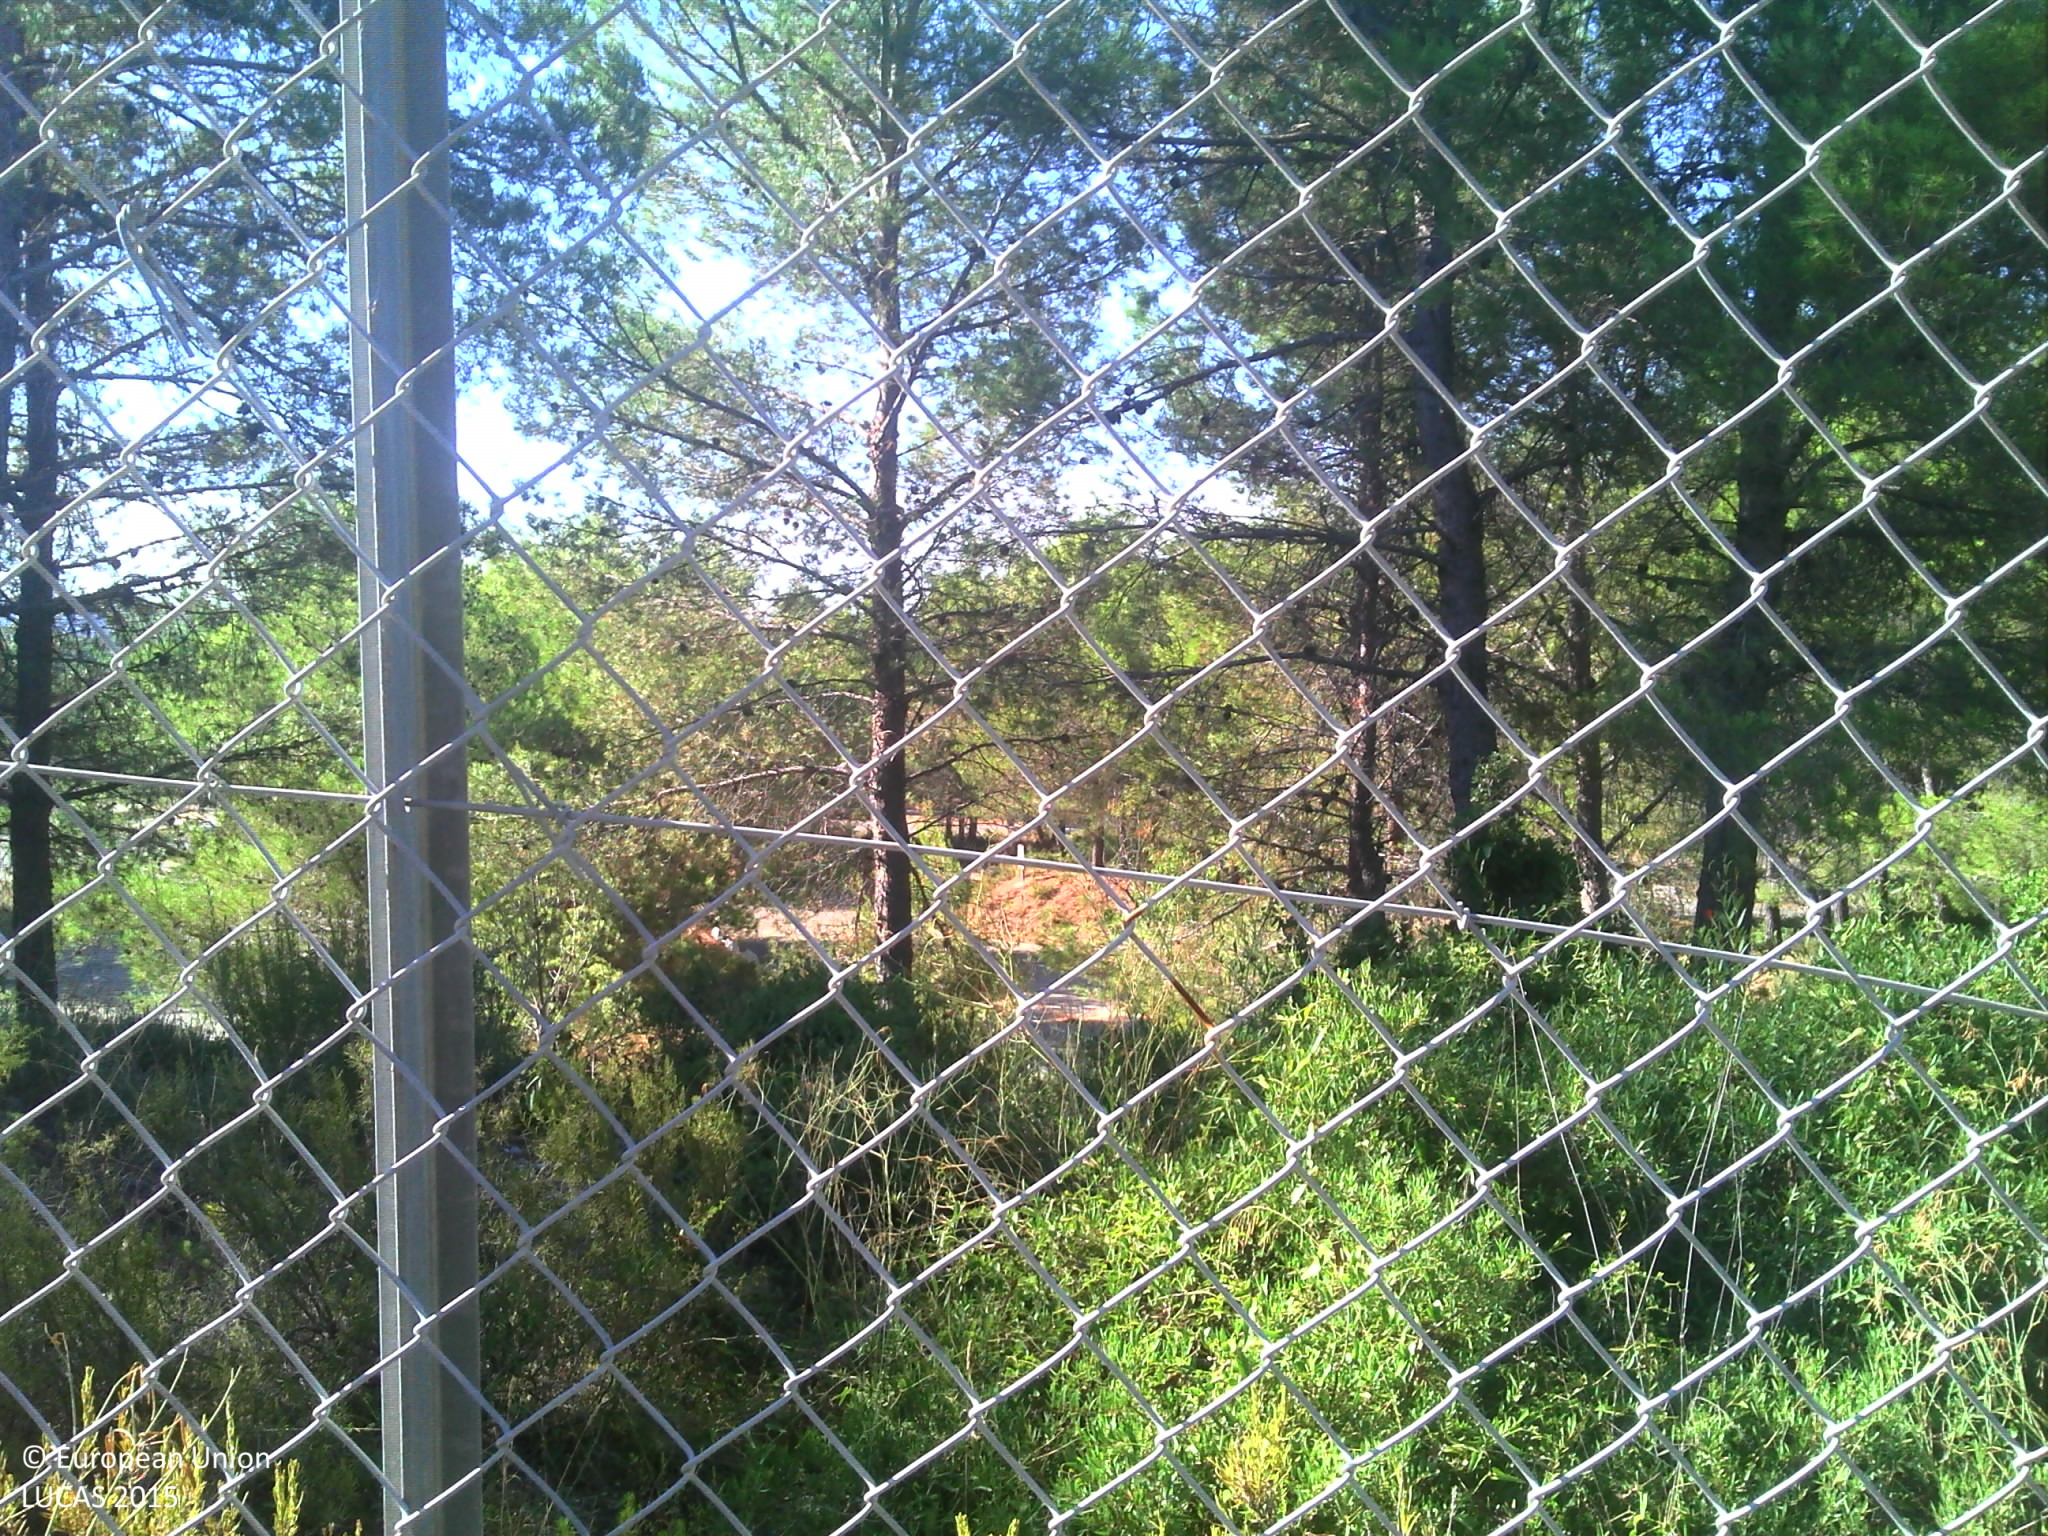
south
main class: Woodland
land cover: Pine dominated coniferous woodland
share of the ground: > 75 %
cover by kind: coniferous forest trees 35 %, herbaceous plants 30 %, consolidated bare surface 25 %, shrubs 10 %
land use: Road transport
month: August
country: FR
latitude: 43.1941
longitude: 5.6666
